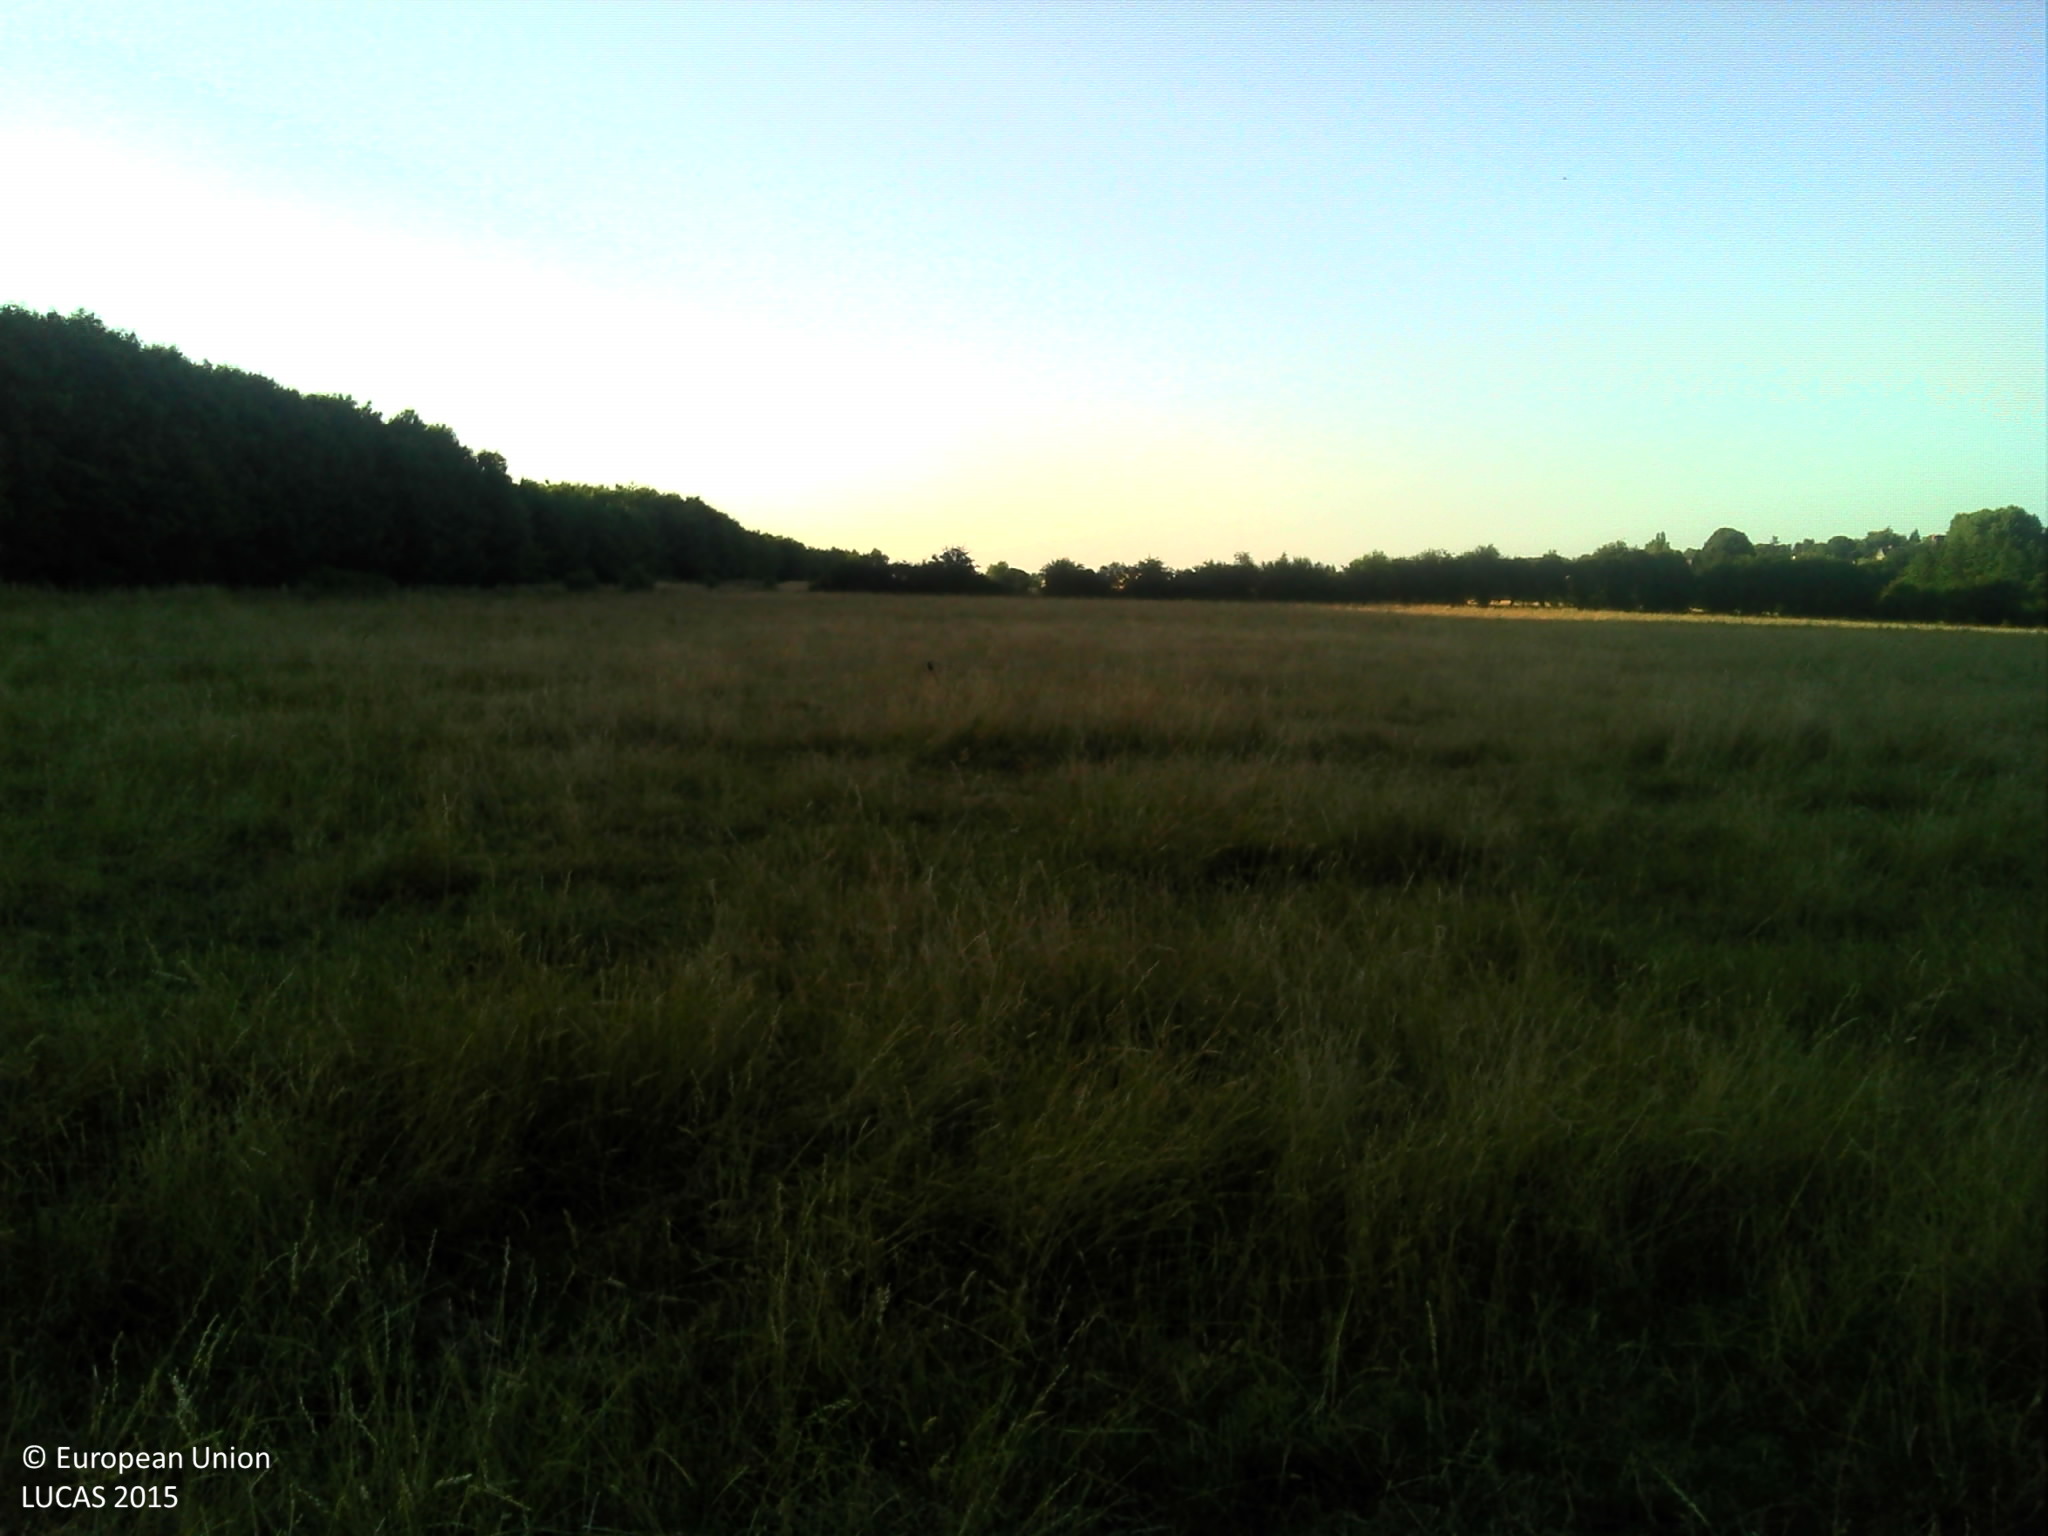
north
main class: Grassland
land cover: Grassland without tree/shrub cover
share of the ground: > 75 %
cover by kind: herbaceous plants 100 %
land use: Agriculture (excluding fallow land and kitchen gardens)
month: July
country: FR
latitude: 48.9016
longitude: 0.7408
